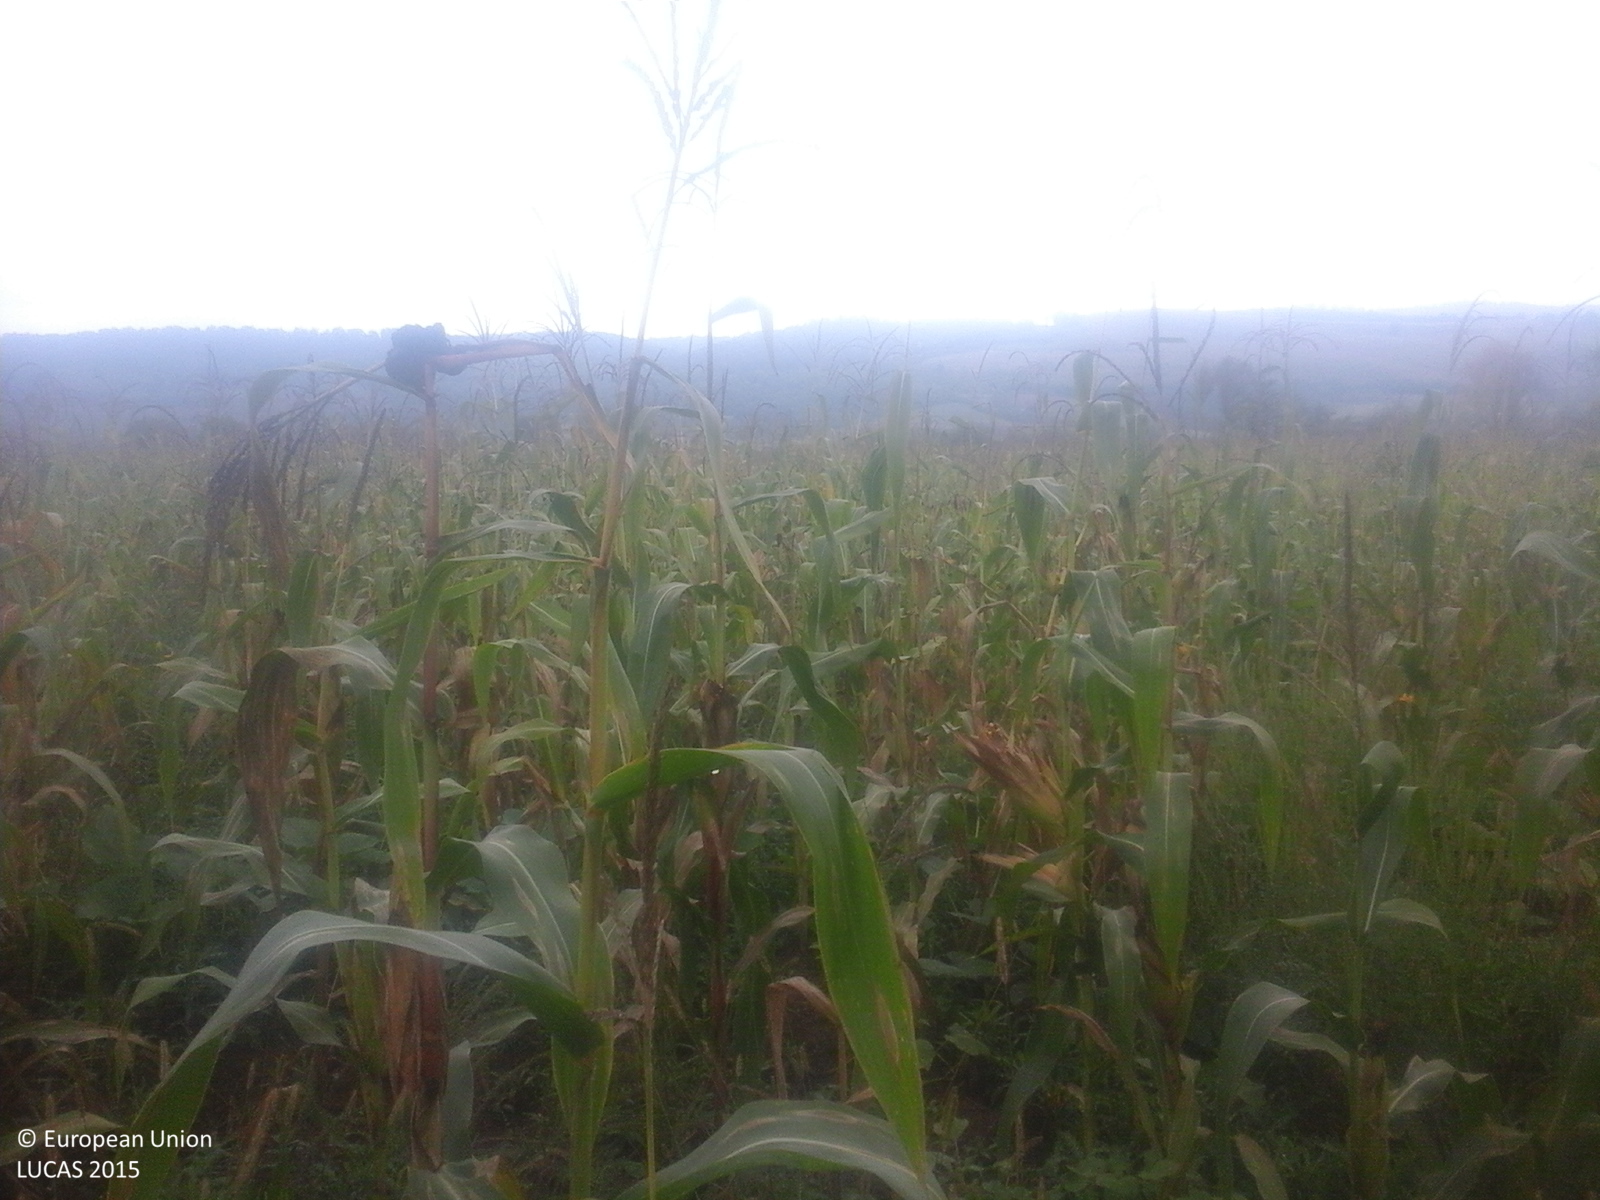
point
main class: Cropland
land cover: Maize
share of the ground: > 75 %
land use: Agriculture (excluding fallow land and kitchen gardens)
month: September
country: RO
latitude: 46.8034
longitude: 22.3018
